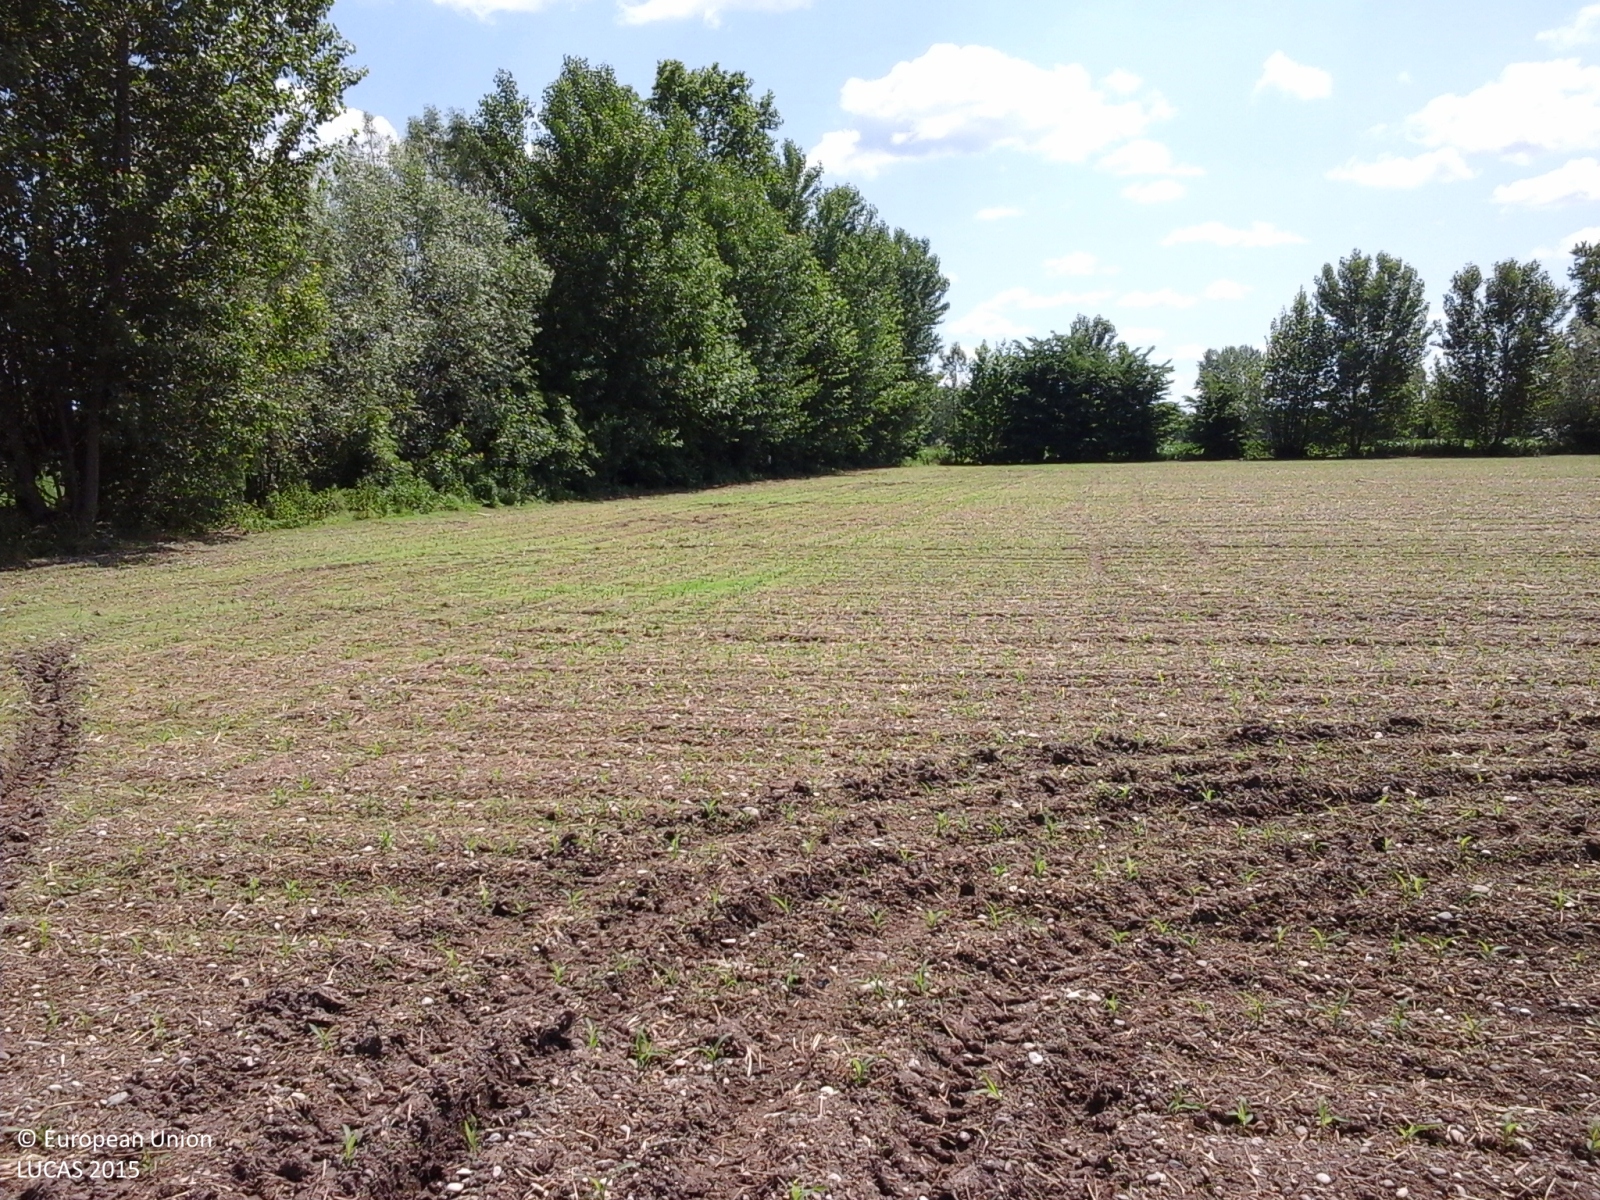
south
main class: Cropland
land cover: Maize
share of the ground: < 10 %
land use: Agriculture (excluding fallow land and kitchen gardens)
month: May
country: IT
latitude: 45.3417
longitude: 10.3185
